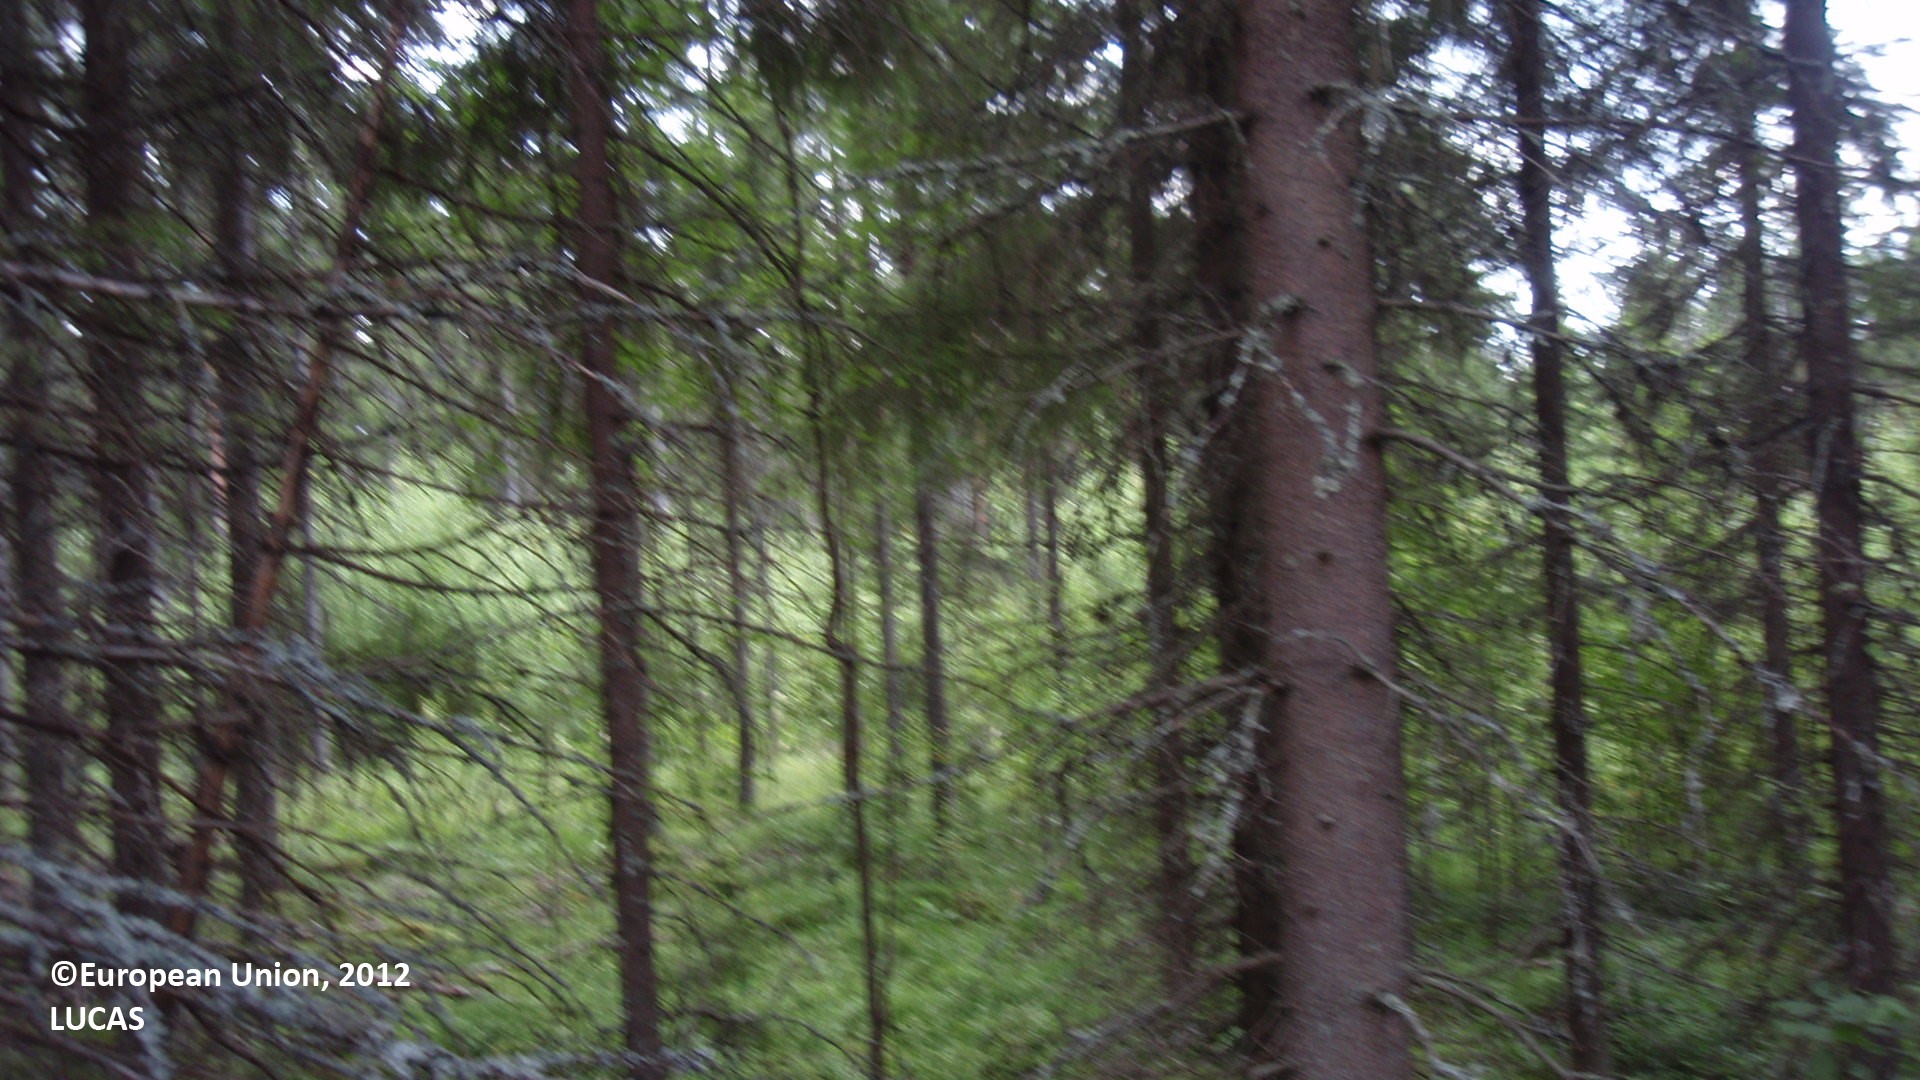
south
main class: Woodland
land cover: Spruce dominated mixed woodland
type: boreal forest
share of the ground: 50 - 75 %
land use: Forestry
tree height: > 5 m
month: July
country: FI
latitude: 61.4331
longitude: 28.7626
